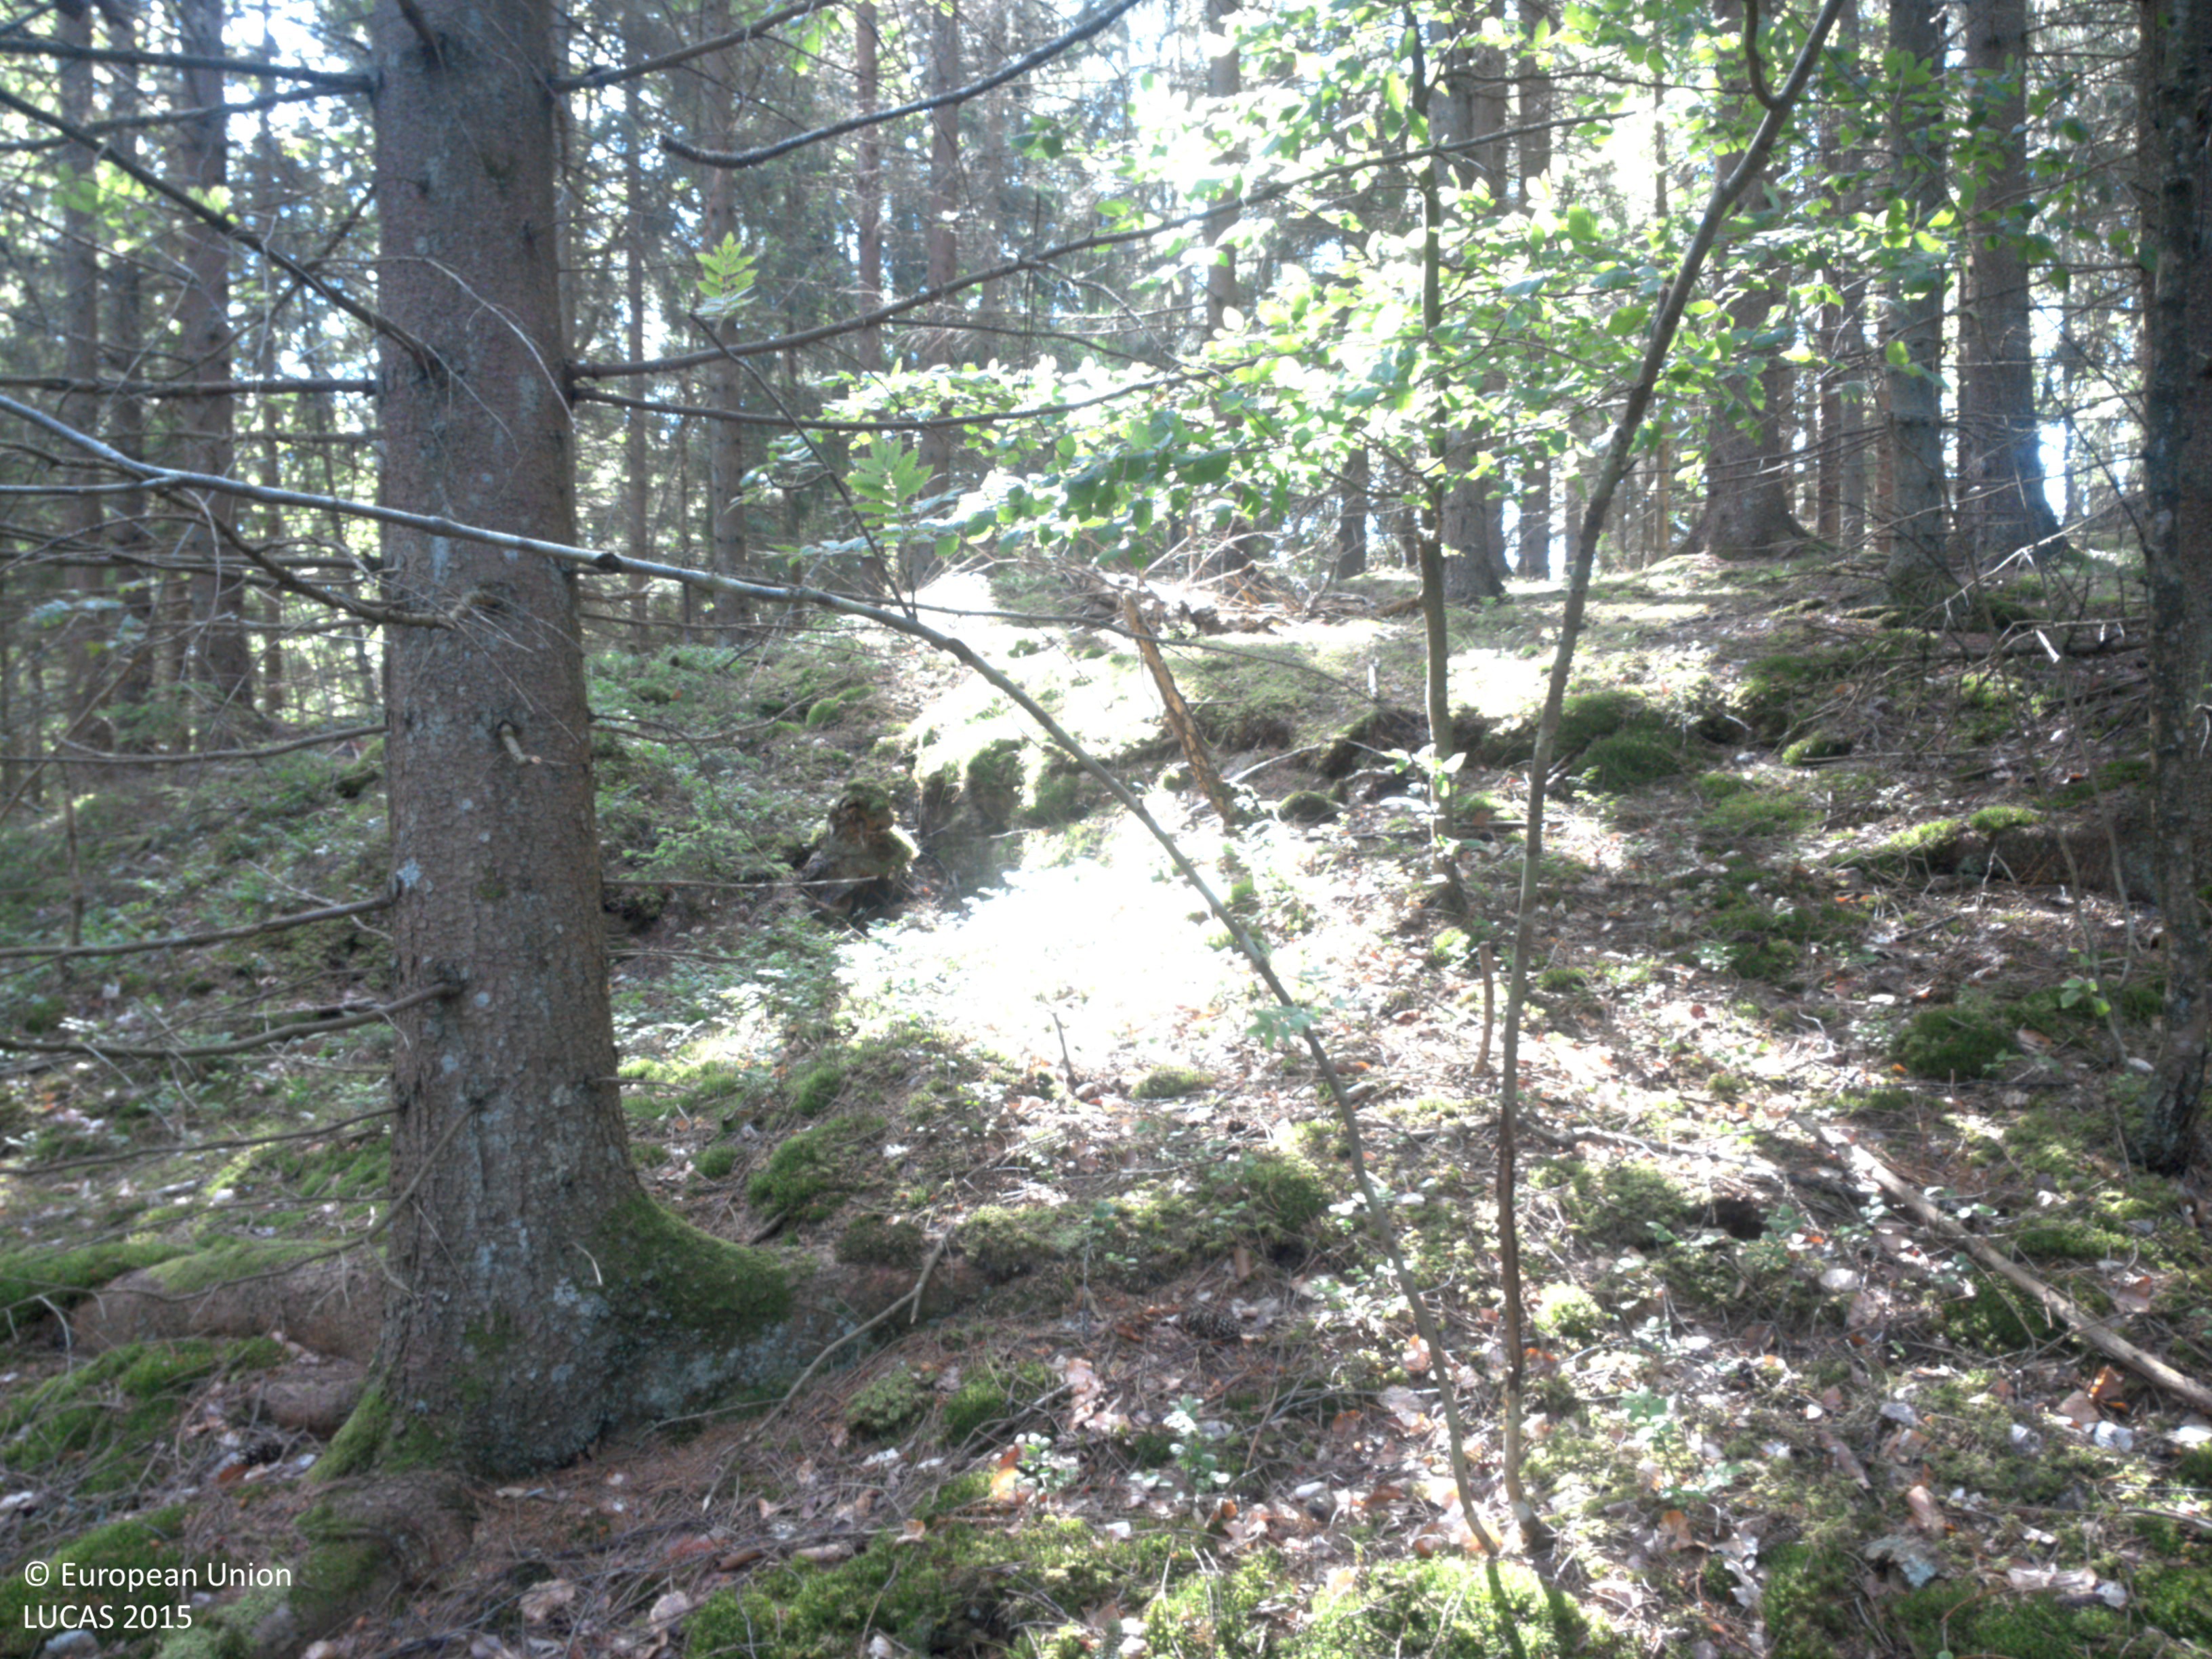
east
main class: Woodland
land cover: Spruce dominated mixed woodland
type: boreal forest
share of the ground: > 75 %
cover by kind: coniferous forest trees 55 %, broadleaved forest trees 25 %, lichens and mosses 20 %
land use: Forestry
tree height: > 5 m
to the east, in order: Spruce dominated mixed woodland; Spruce dominated coniferous woodland; Spruce dominated mixed woodland; Spruce dominated coniferous woodland; Tracks; Spruce dominated mixed woodland; Rock outcrops; Broadleaved woodland; Ditches and canals; Grassland without tree/shrub cover; Broadleaved woodland; Ditches and canals; Broadleaved woodland
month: June
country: SE
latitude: 58.4439
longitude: 11.5899
